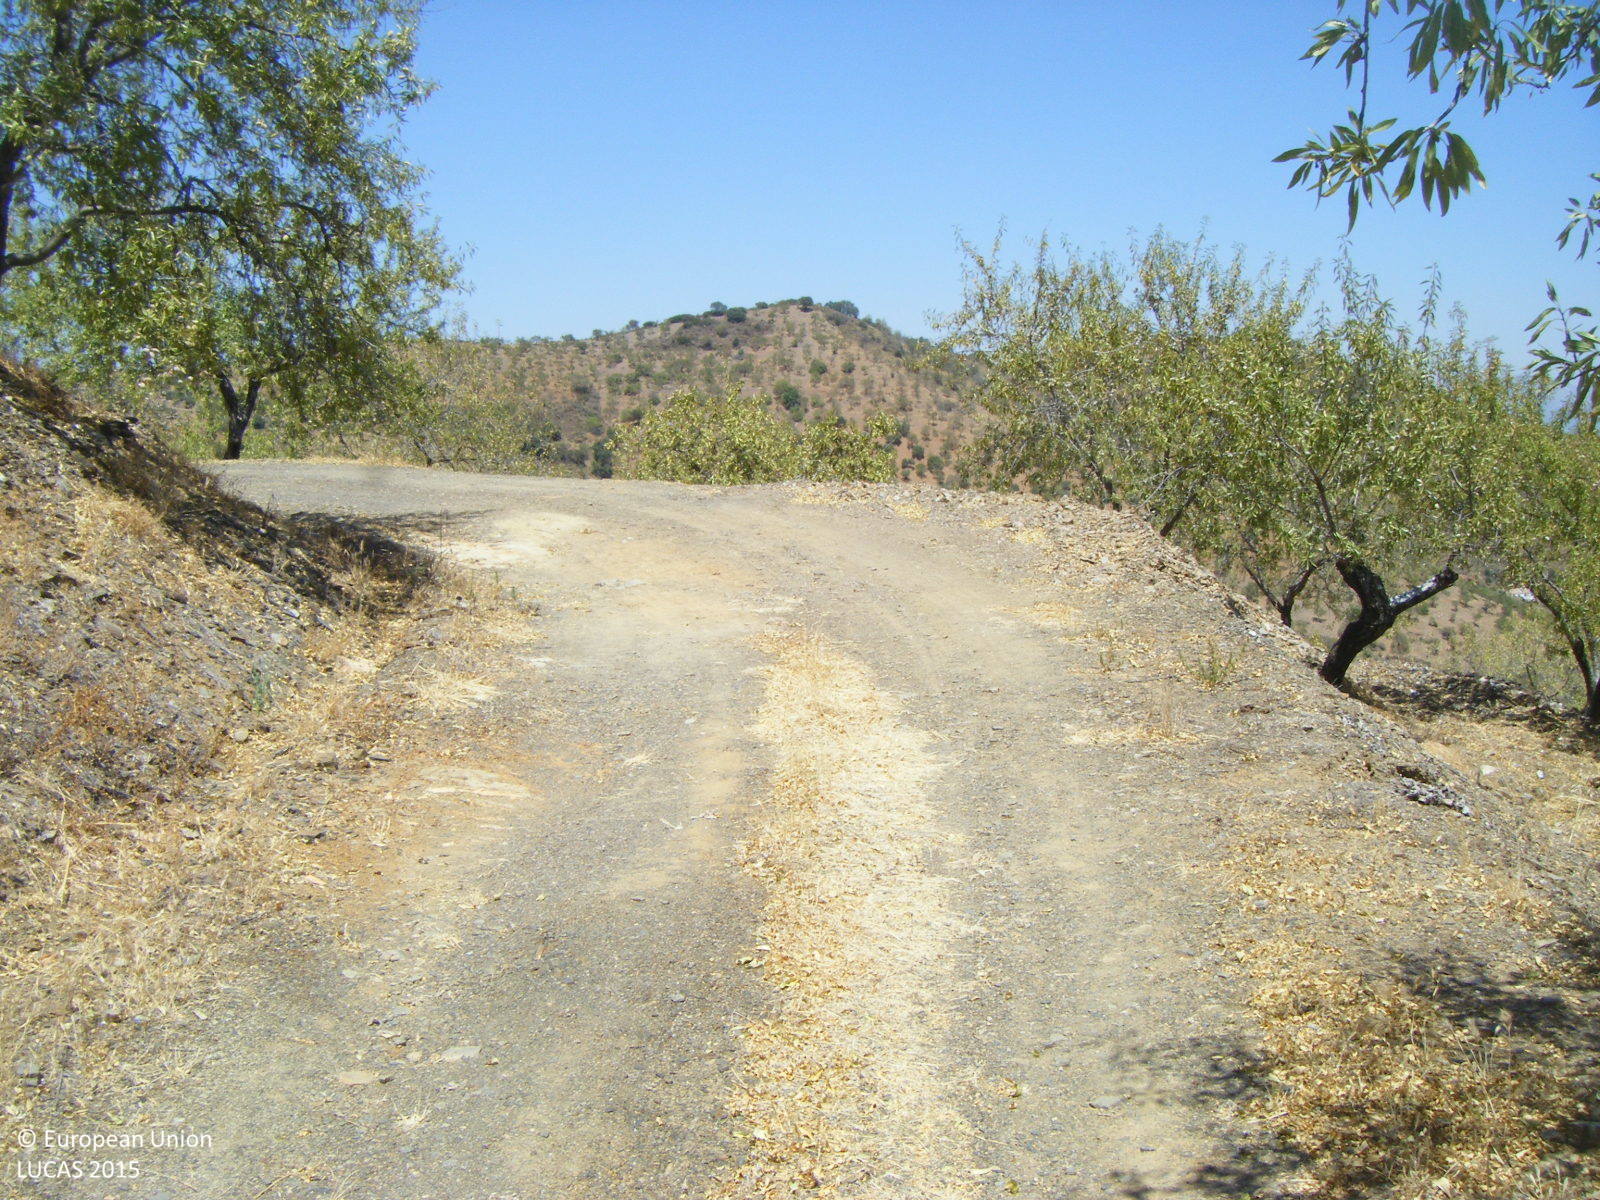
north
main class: Cropland
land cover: Nuts trees
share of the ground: 10 - 25 %
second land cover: Spontaneously vegetated surfaces
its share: > 75 %
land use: Agriculture (excluding fallow land and kitchen gardens)
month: July
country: ES
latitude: 36.8039
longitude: -4.3257
